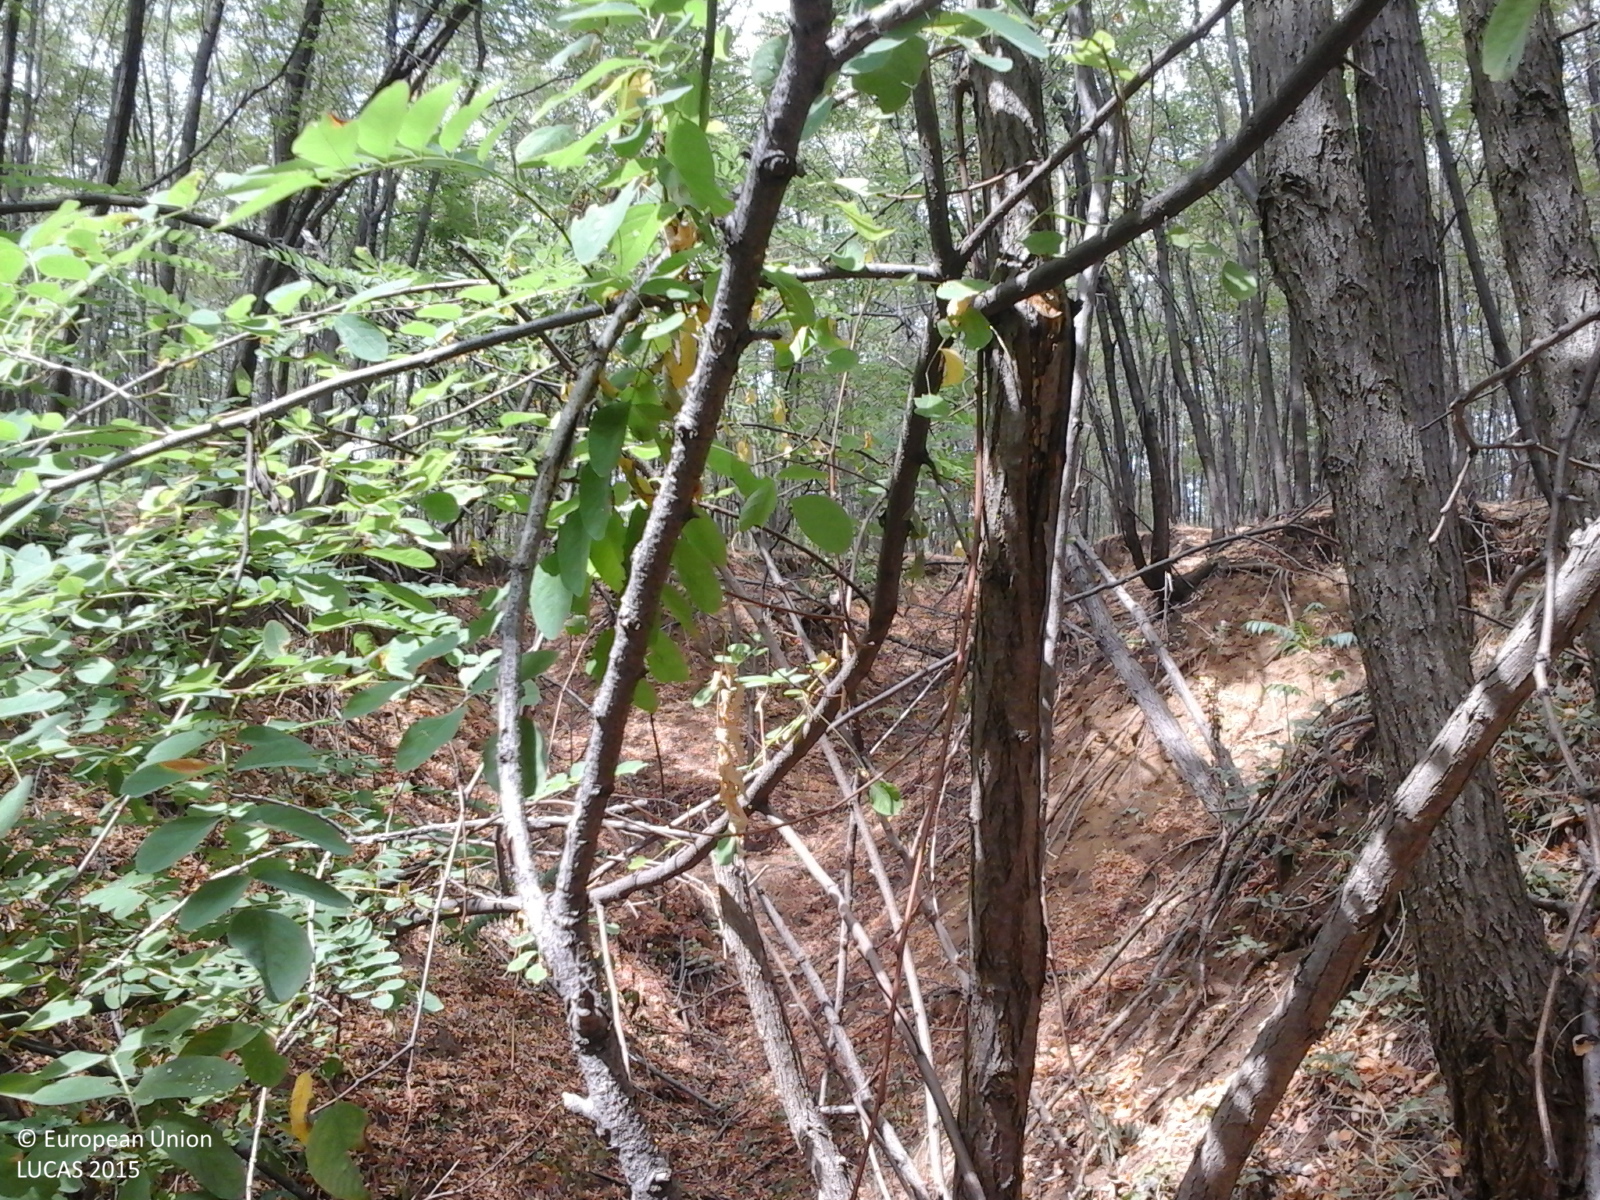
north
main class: Woodland
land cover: Broadleaved woodland
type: exotic forest
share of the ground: > 75 %
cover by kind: broadleaved forest trees 100 %
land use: Forestry
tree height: > 5 m
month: August
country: RO
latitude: 44.6558
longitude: 22.7418
